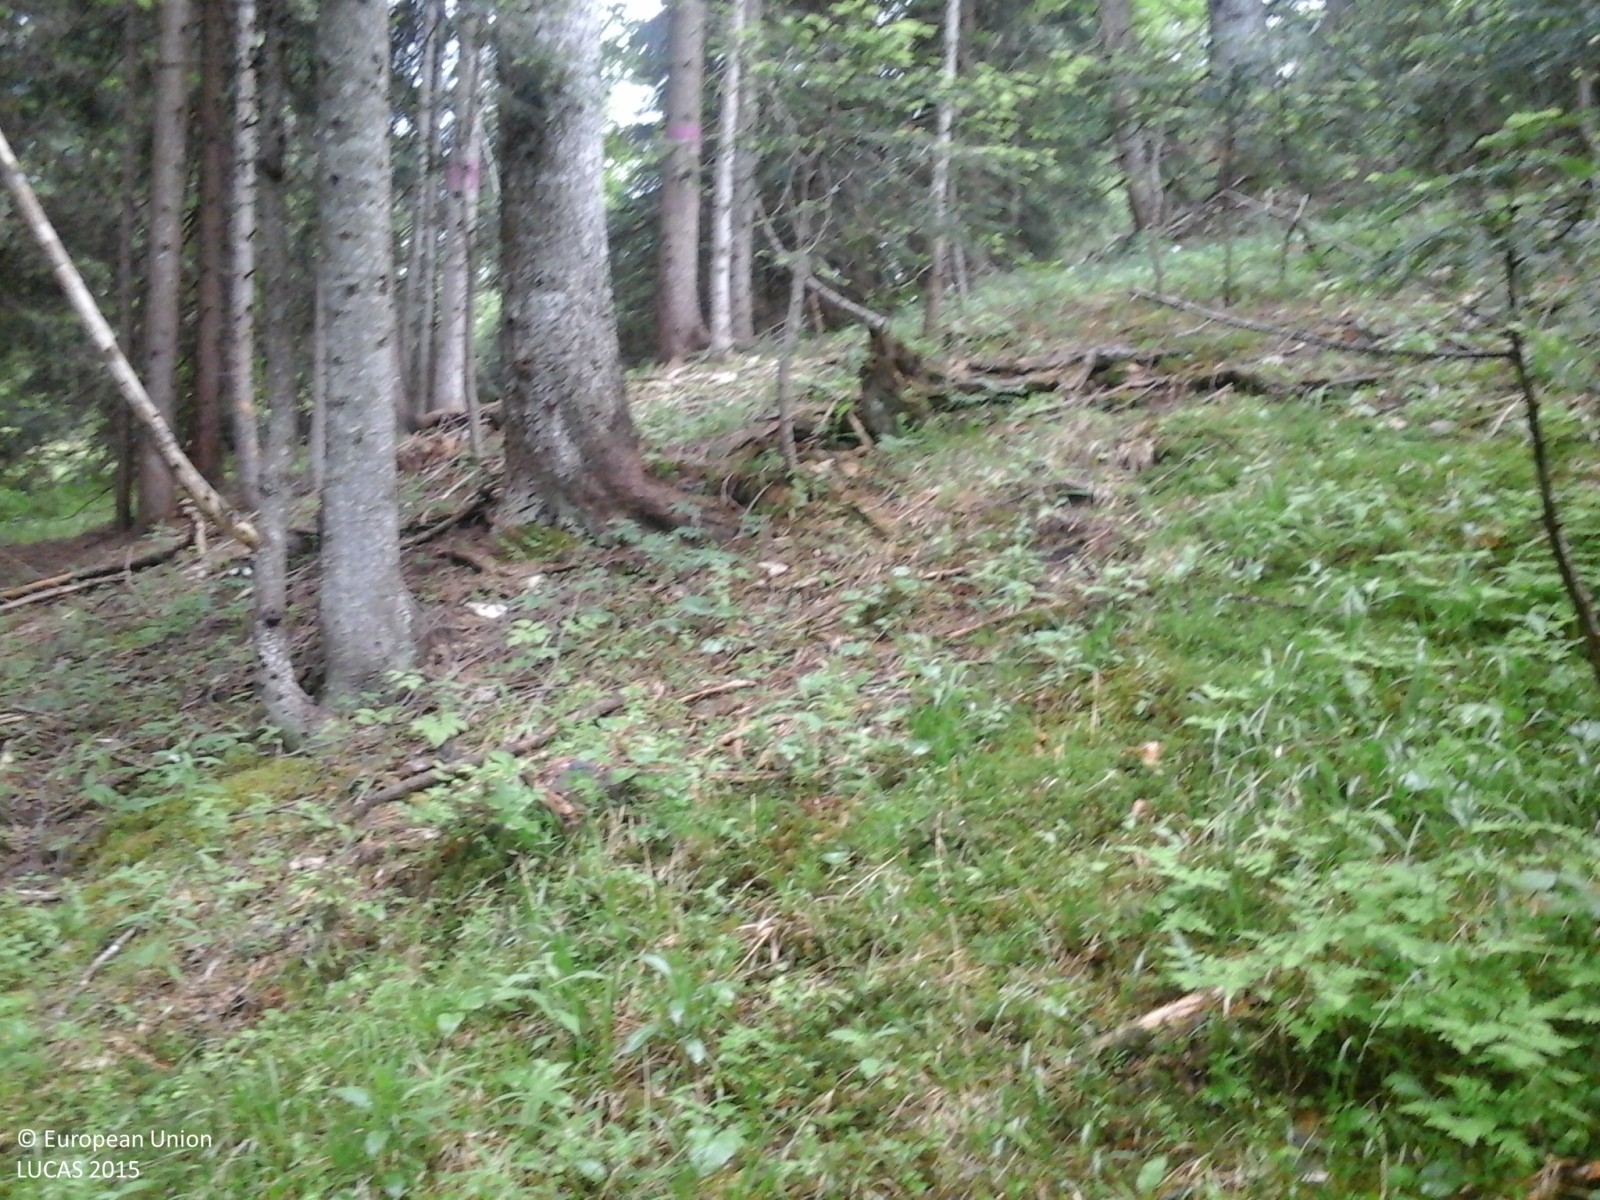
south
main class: Woodland
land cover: Other coniferous woodland
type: alpine coniferous forest
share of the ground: > 75 %
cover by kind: coniferous forest trees 100 %
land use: Forestry
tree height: > 5 m
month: June
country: IT
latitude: 46.5745
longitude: 12.4896
